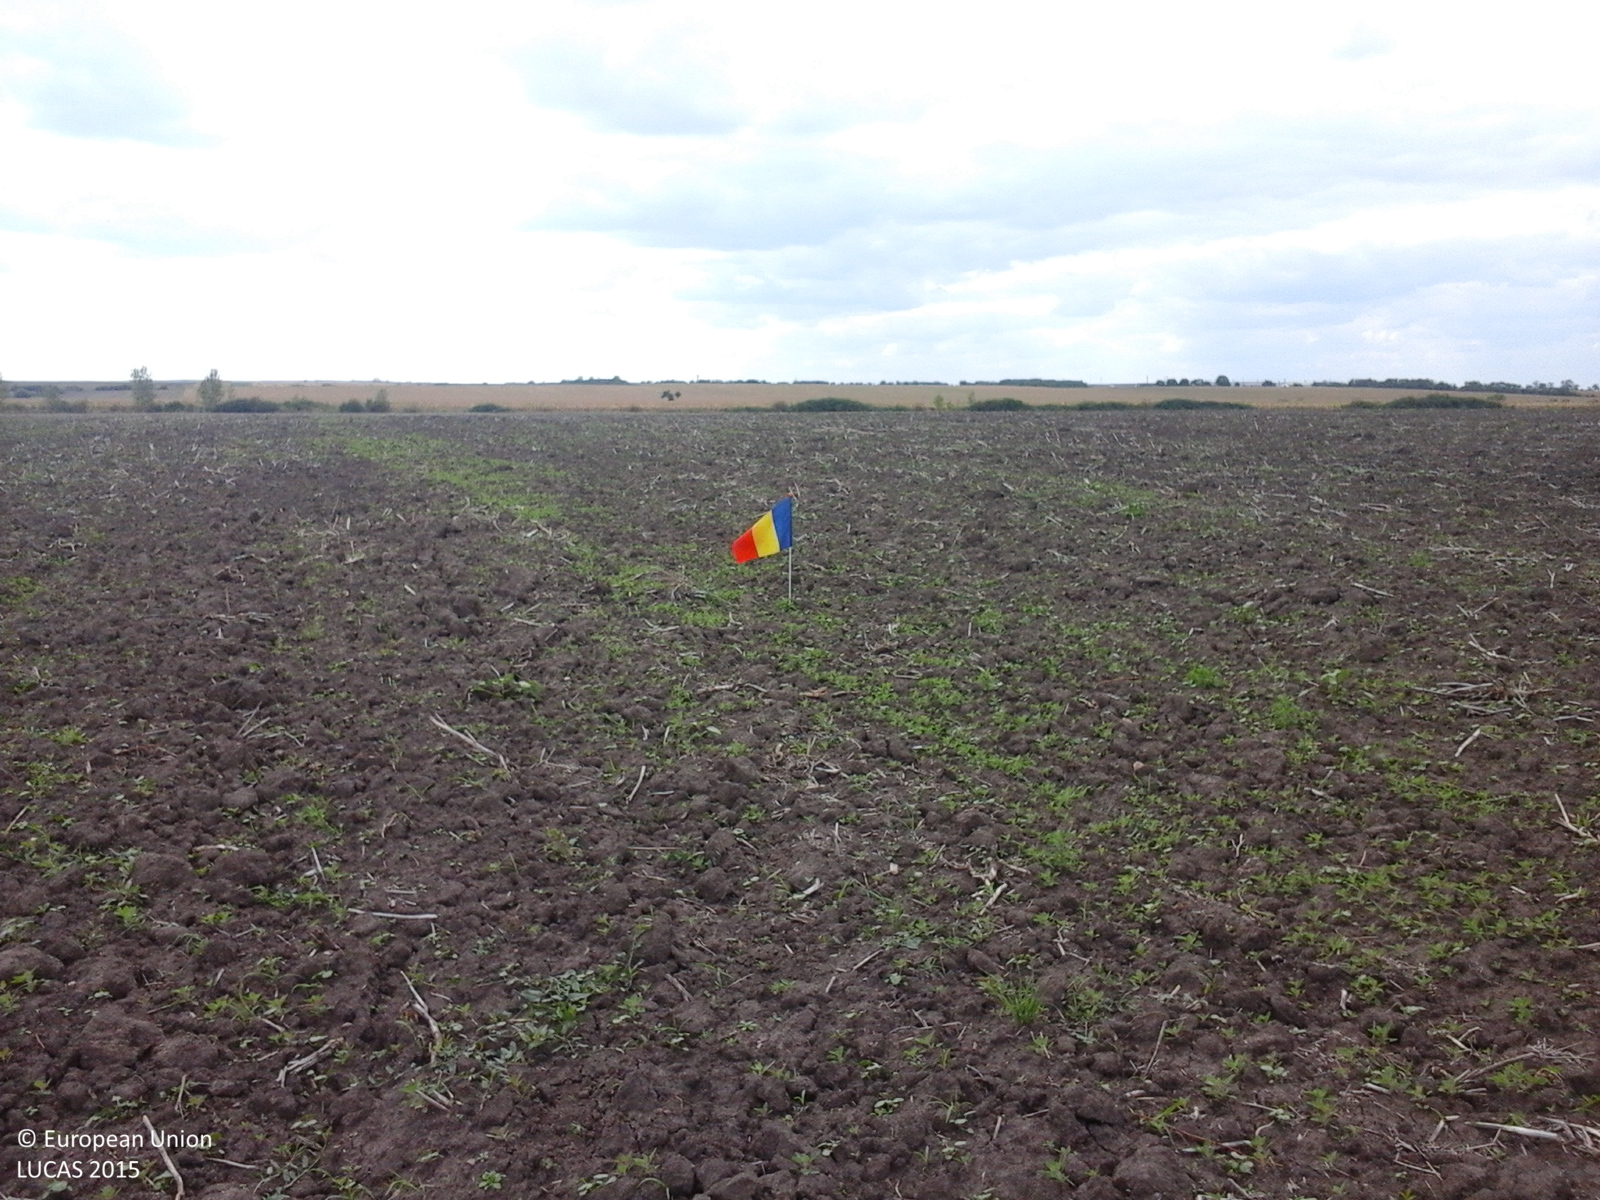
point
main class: Cropland
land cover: Rape and turnip rape
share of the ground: < 10 %
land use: Agriculture (excluding fallow land and kitchen gardens)
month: September
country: RO
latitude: 47.5084
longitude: 22.6597
